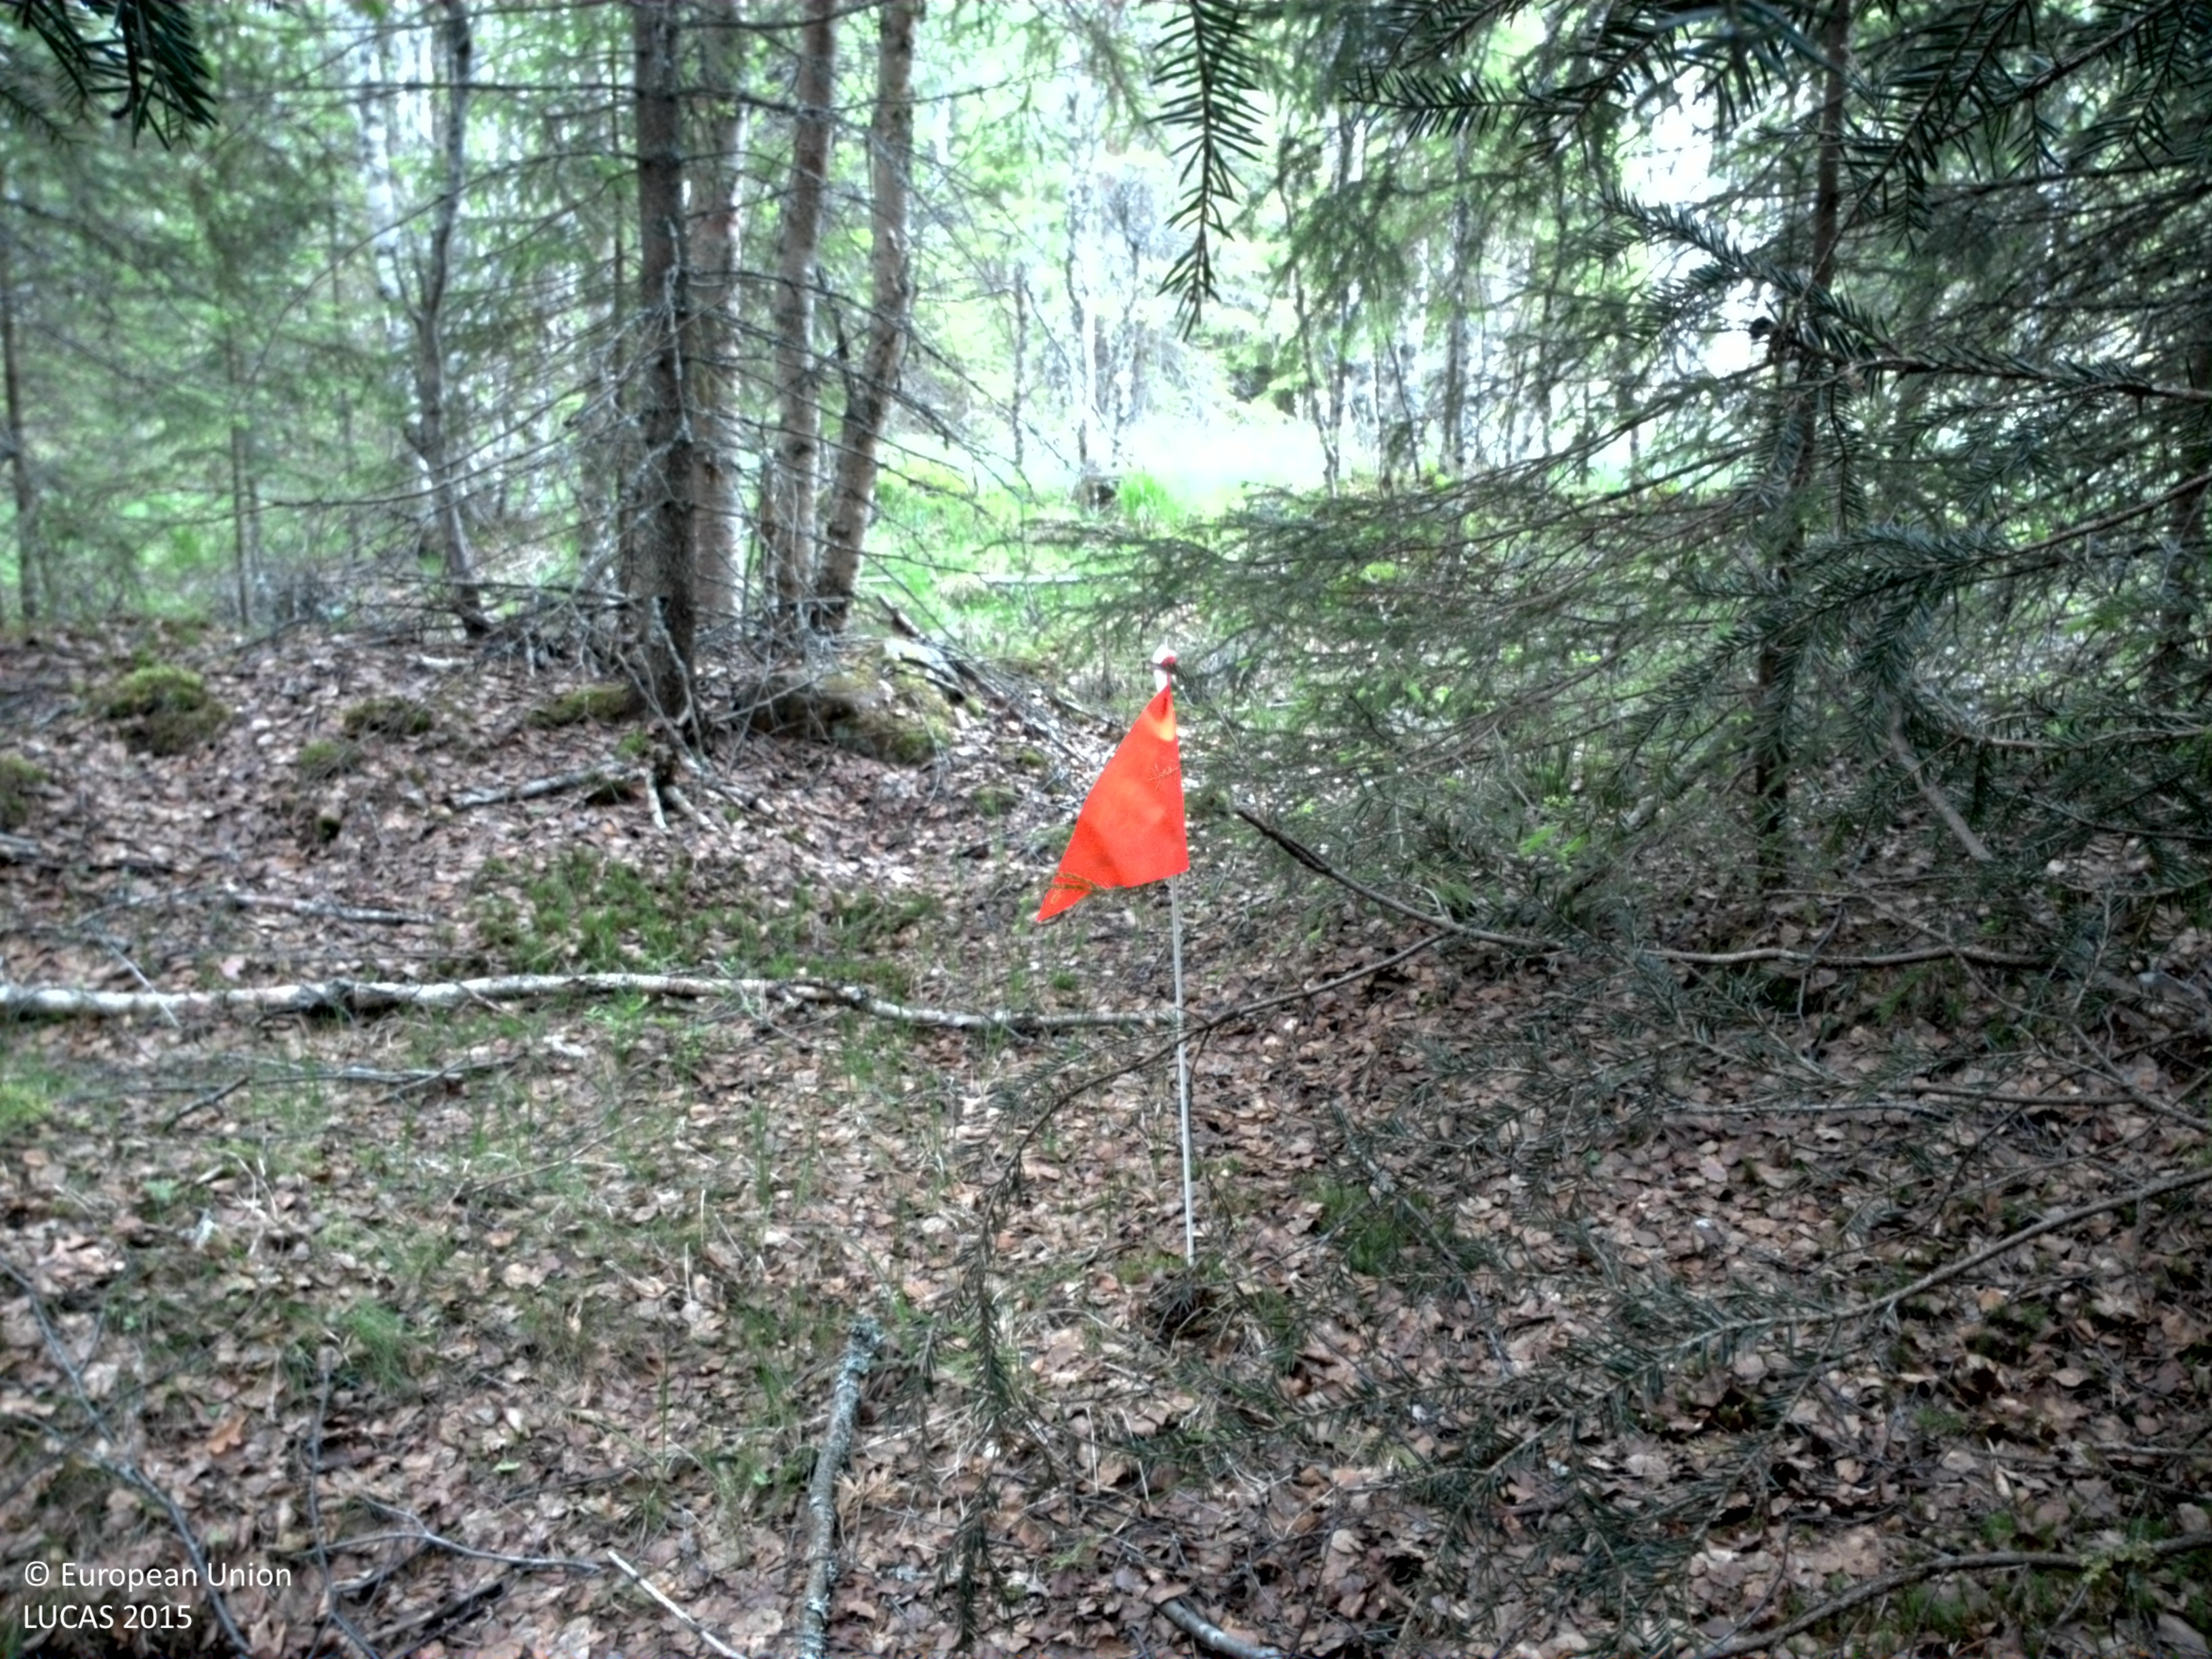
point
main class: Woodland
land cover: Other mixed woodland
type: boreal forest
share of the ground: > 75 %
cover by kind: coniferous forest trees 40 %, broadleaved forest trees 40 %, herbaceous plants 10 %, lichens and mosses 10 %
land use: Forestry
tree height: > 5 m
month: June
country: SE
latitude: 61.1448
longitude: 13.5731
